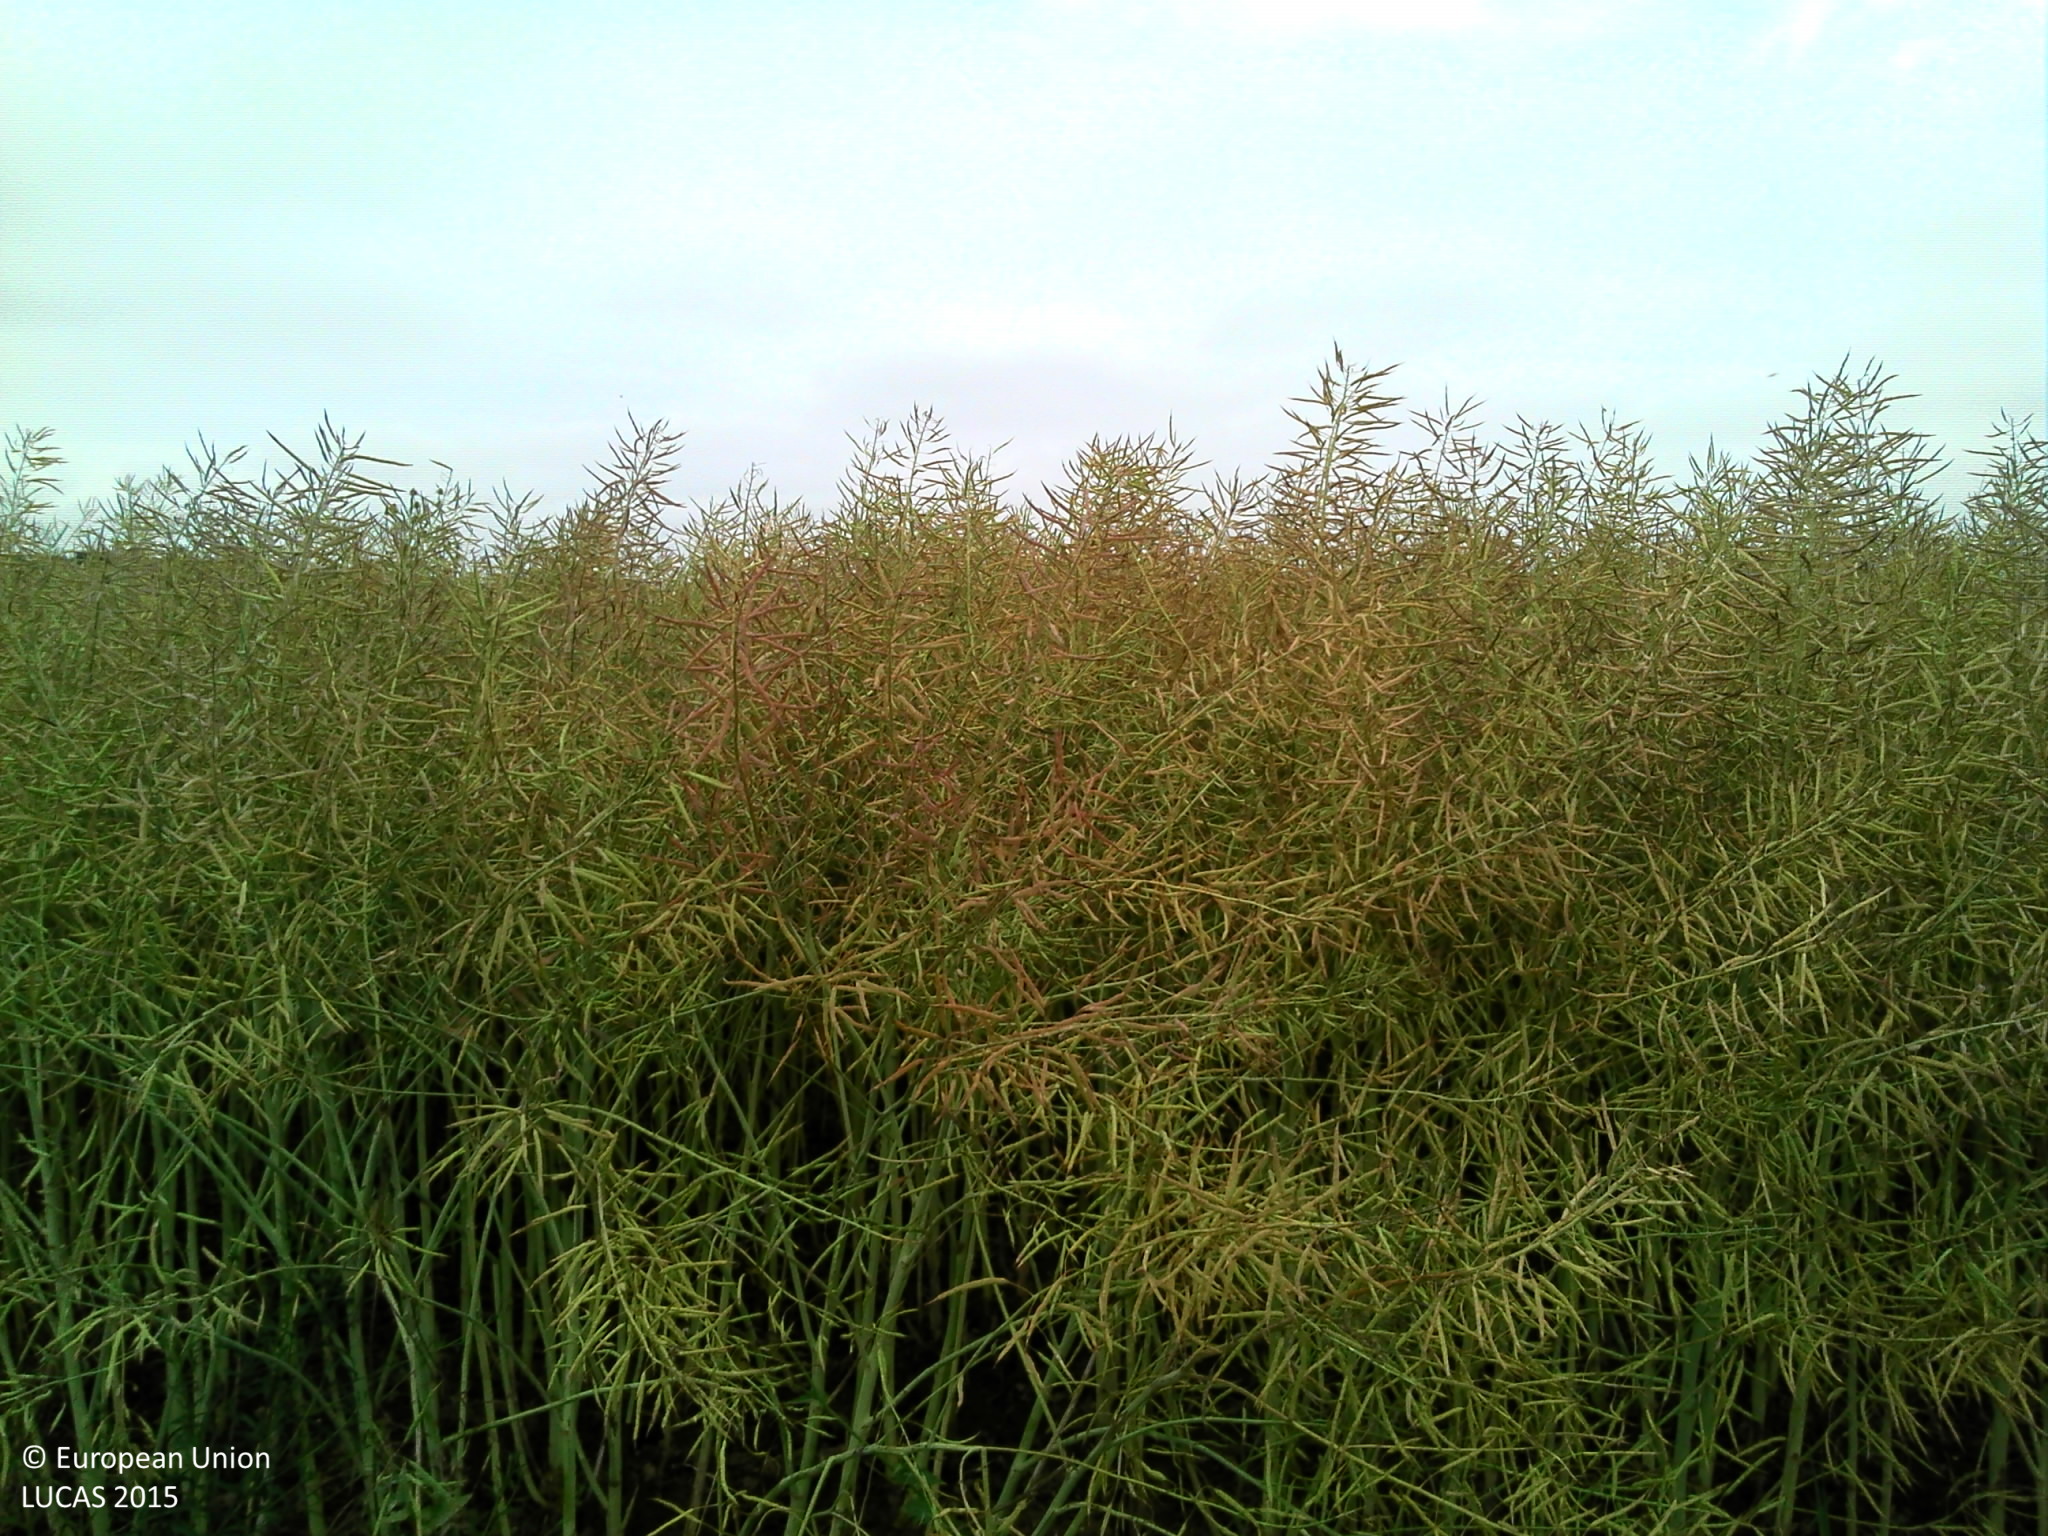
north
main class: Cropland
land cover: Rape and turnip rape
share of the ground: > 75 %
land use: Agriculture (excluding fallow land and kitchen gardens)
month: June
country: FR
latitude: 46.5285
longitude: 0.5308
